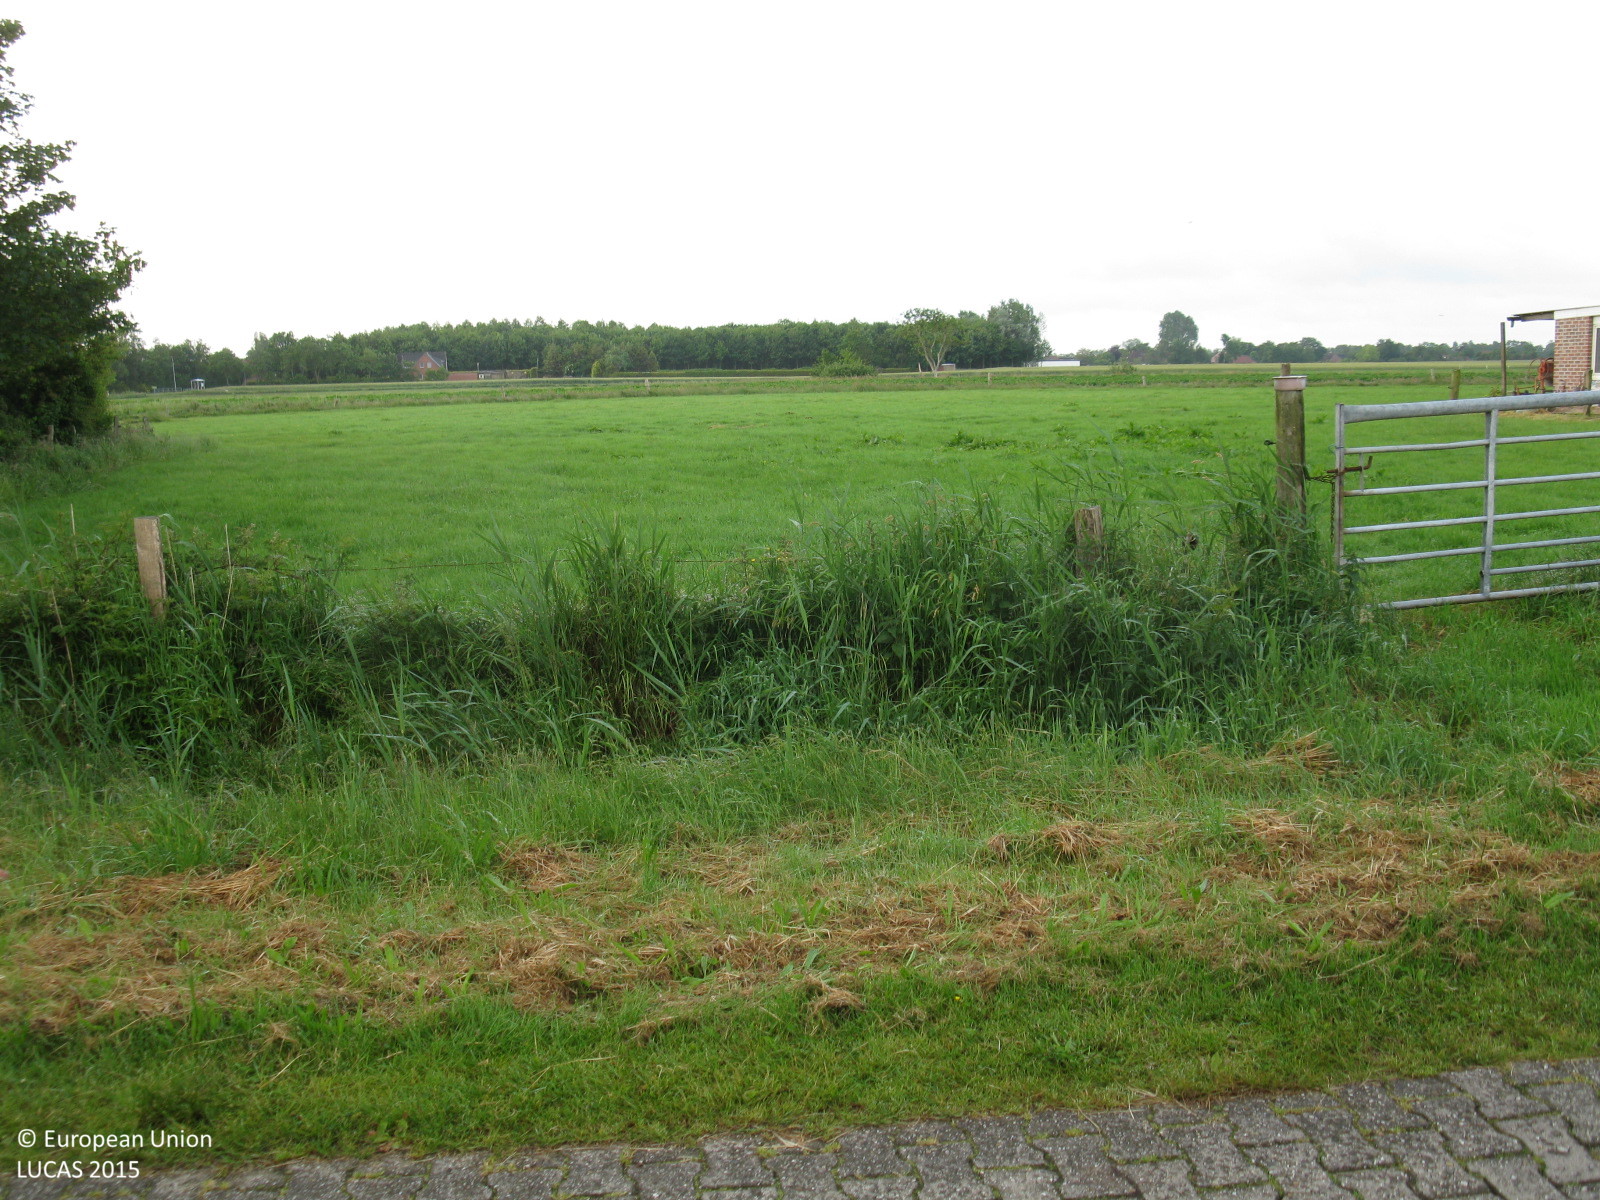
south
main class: Grassland
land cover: Grassland without tree/shrub cover
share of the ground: > 75 %
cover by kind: herbaceous plants 100 %
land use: Agriculture (excluding fallow land and kitchen gardens)
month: June
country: DE
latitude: 53.5337
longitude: 7.3000
